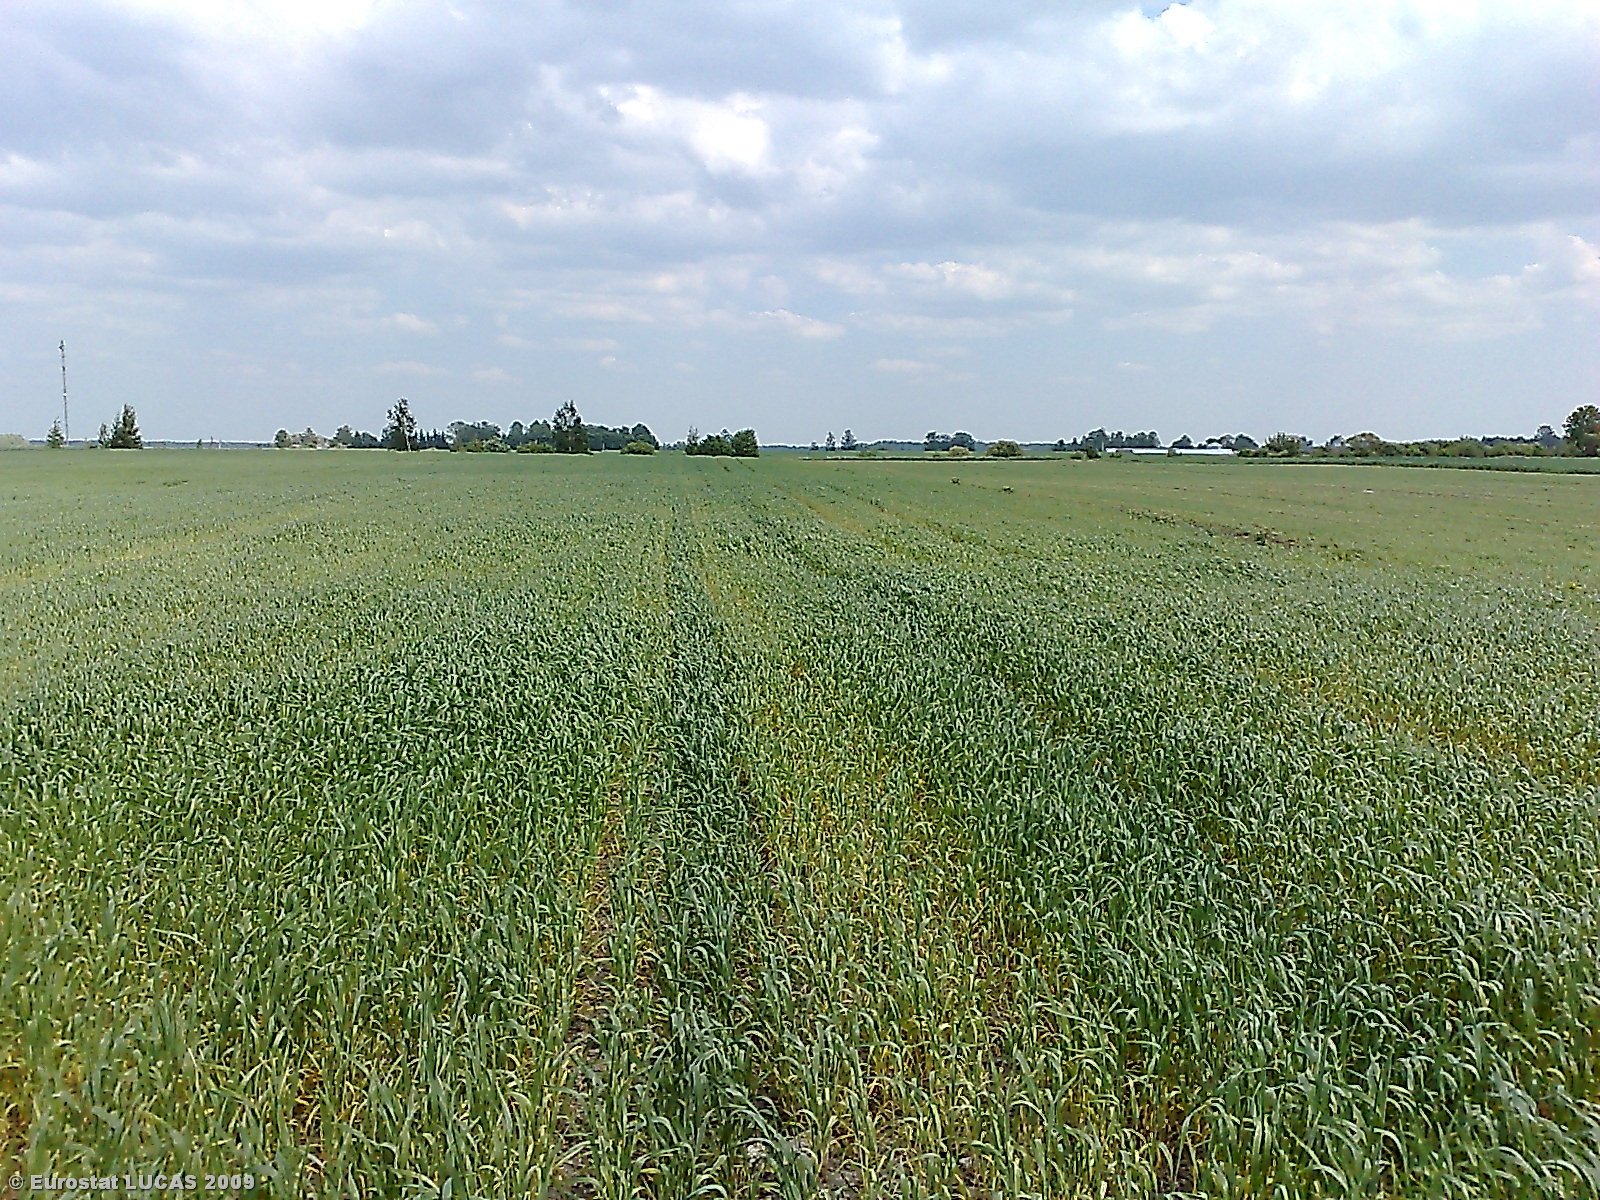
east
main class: Cropland
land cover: Common wheat
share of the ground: > 75 %
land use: Agriculture (excluding fallow land and kitchen gardens)
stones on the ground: < 10 %
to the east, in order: Common wheat; Grass margins; Ditches and canals; Single bushes/trees; Grass margins; Common wheat
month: May
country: LT
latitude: 56.2577
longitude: 23.9845
